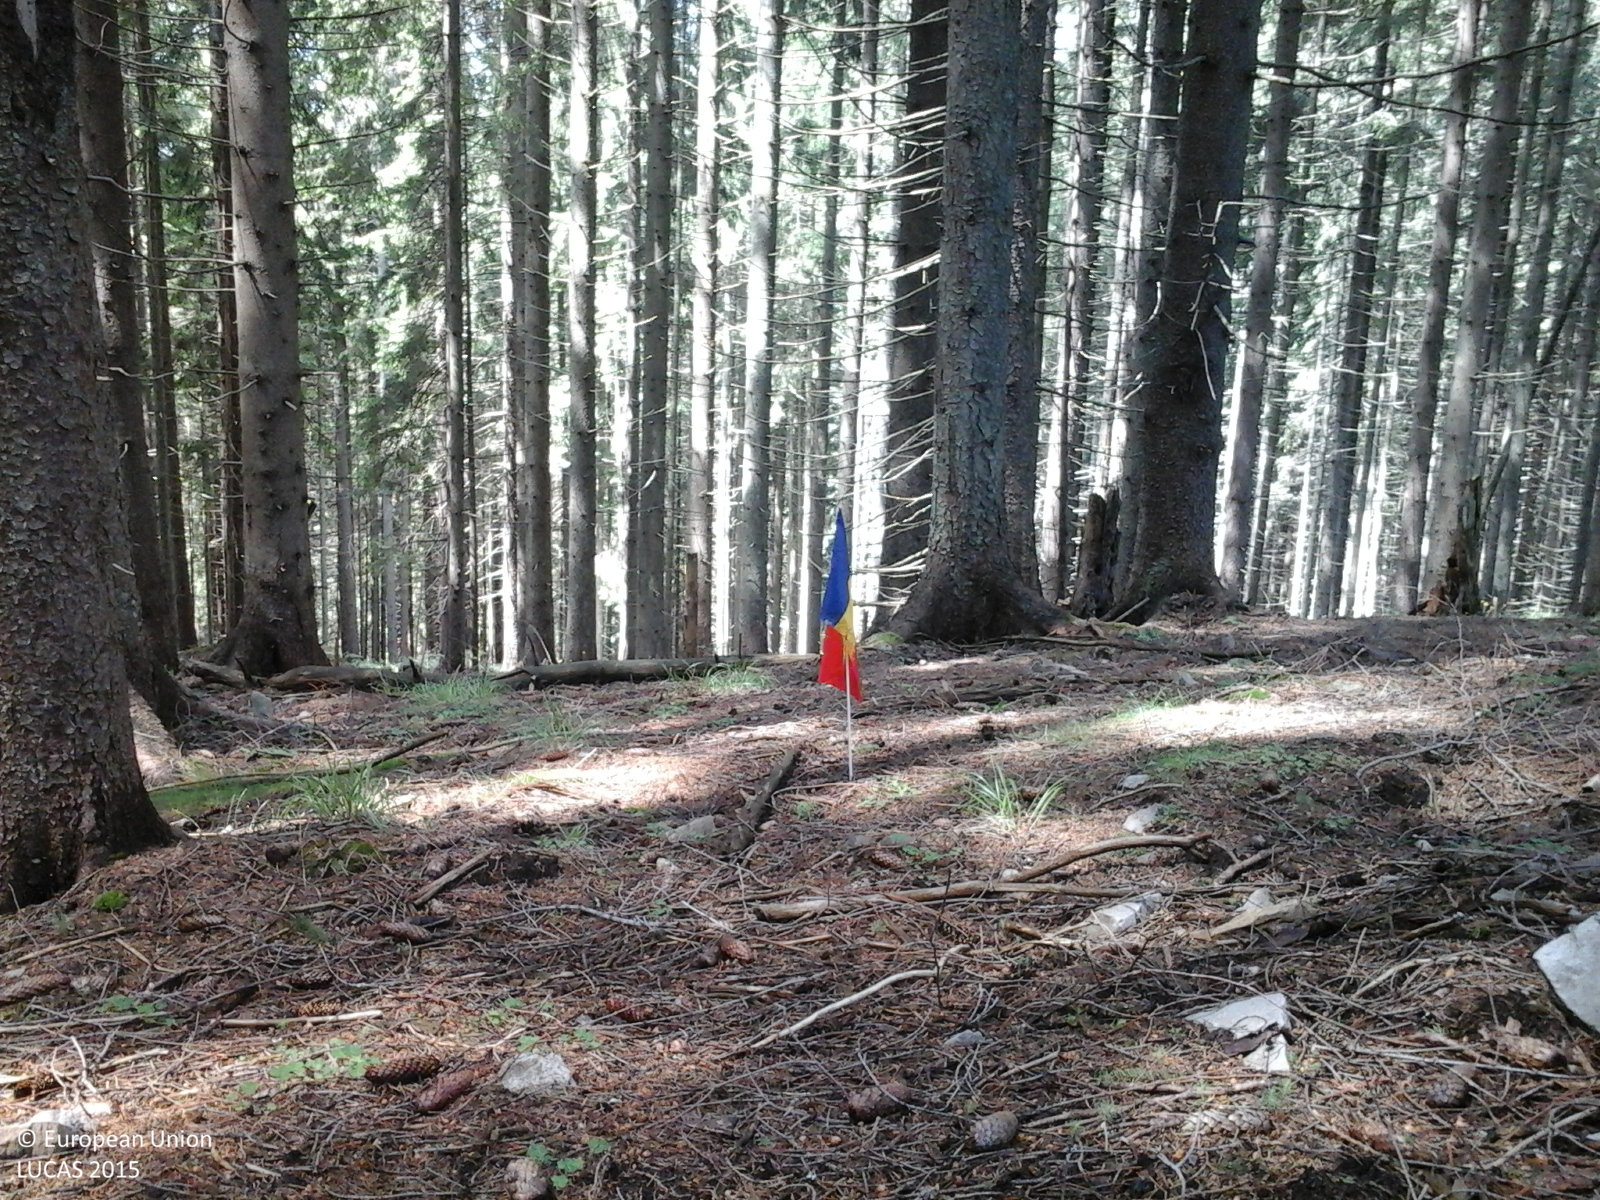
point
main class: Woodland
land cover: Other coniferous woodland
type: alpine coniferous forest
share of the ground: > 75 %
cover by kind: coniferous forest trees 100 %
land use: Forestry
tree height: > 5 m
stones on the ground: 10 - 25 %
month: June
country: RO
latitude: 47.7582
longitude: 25.2535
